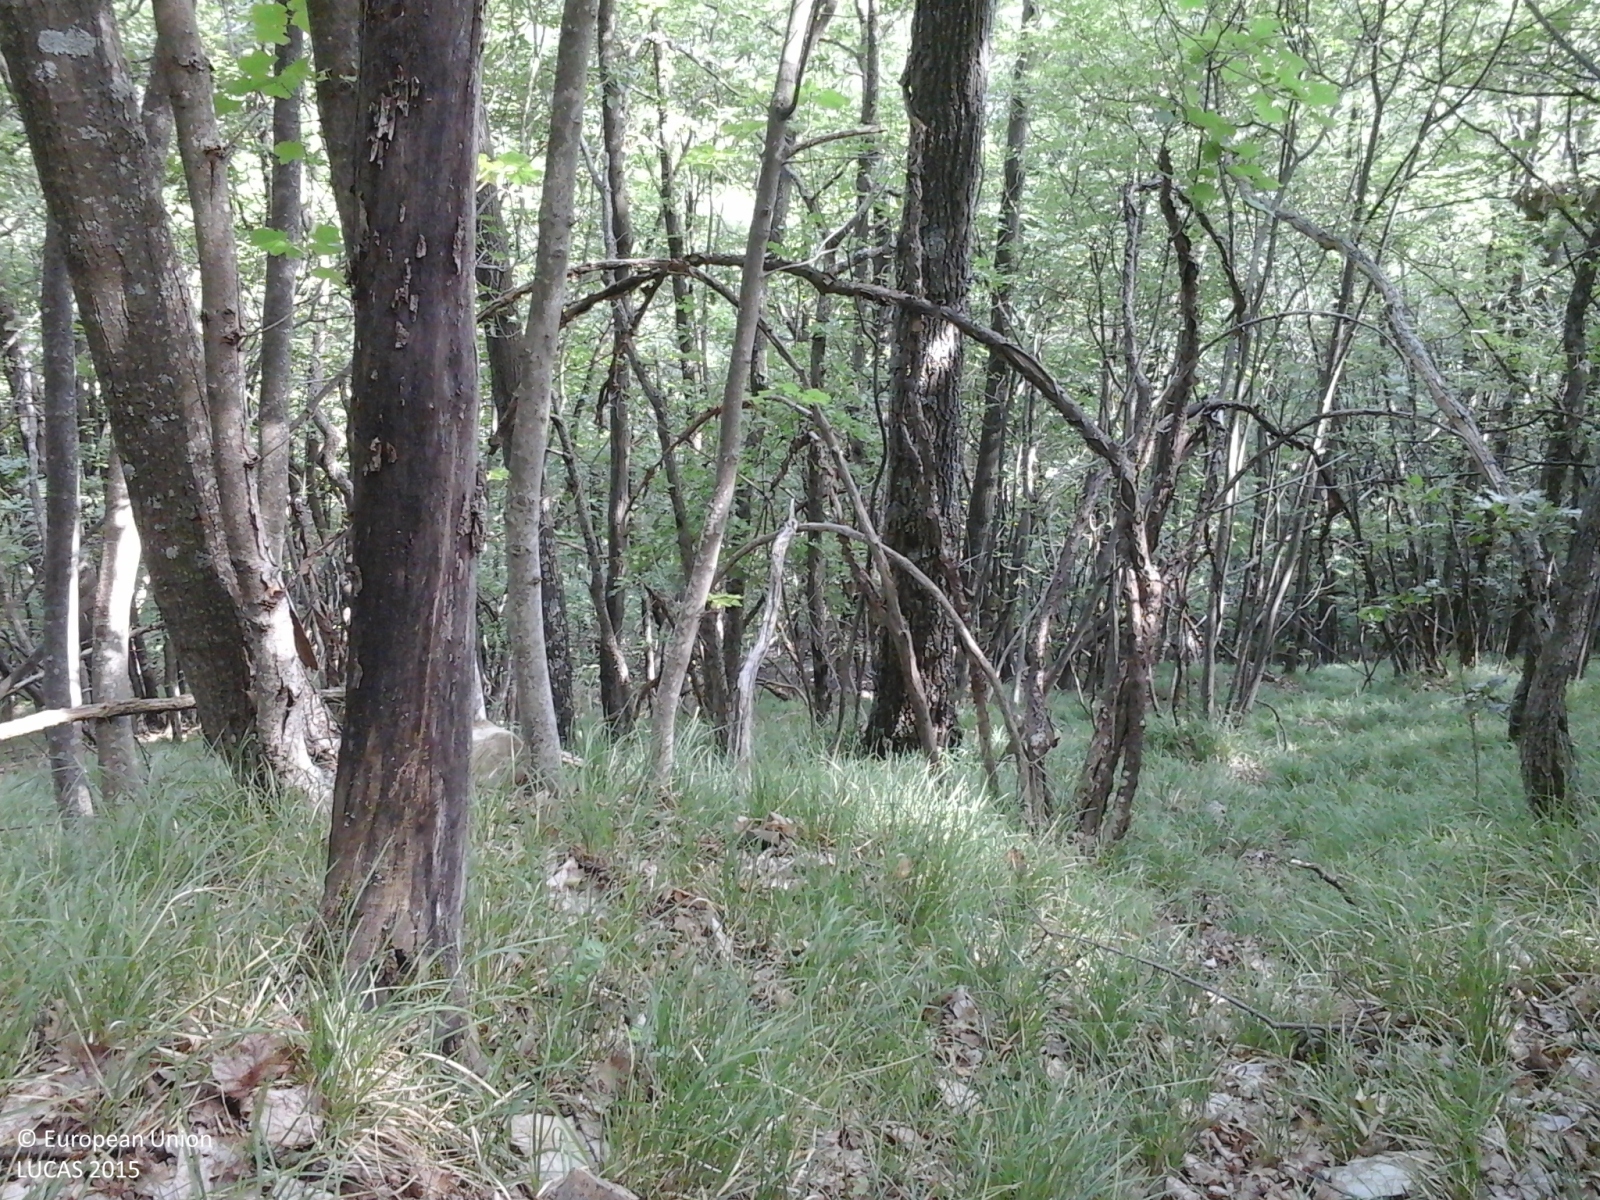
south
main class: Woodland
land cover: Broadleaved woodland
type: mesophytic deciduous forest
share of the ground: > 75 %
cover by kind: broadleaved forest trees 100 %
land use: Forestry
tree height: > 5 m
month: June
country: IT
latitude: 44.6896
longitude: 9.1312
